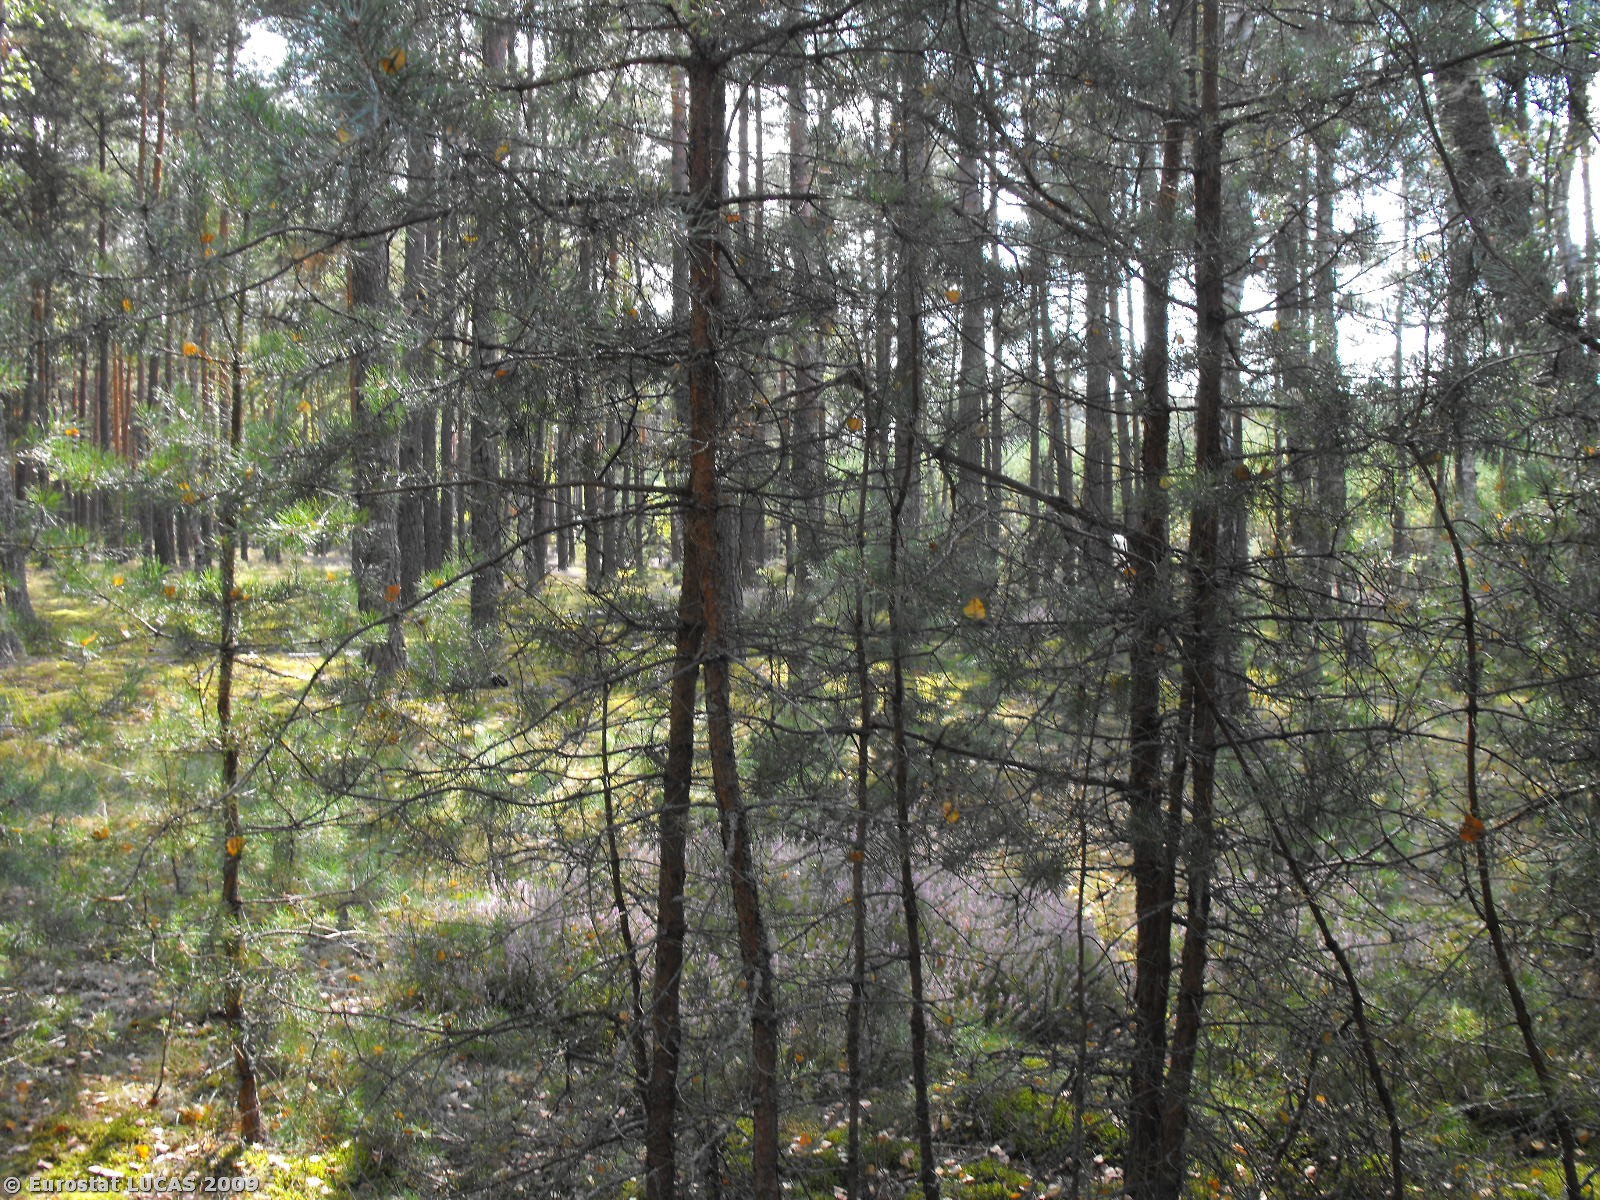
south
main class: Woodland
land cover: Coniferous woodland
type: hemiboreal forest and nemoral coniferous forest and mixed broadleaved-coniferous forest
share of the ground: 50 - 75 %
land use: Forestry
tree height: > 5 m
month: September
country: PL
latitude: 52.7820
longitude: 16.3969
